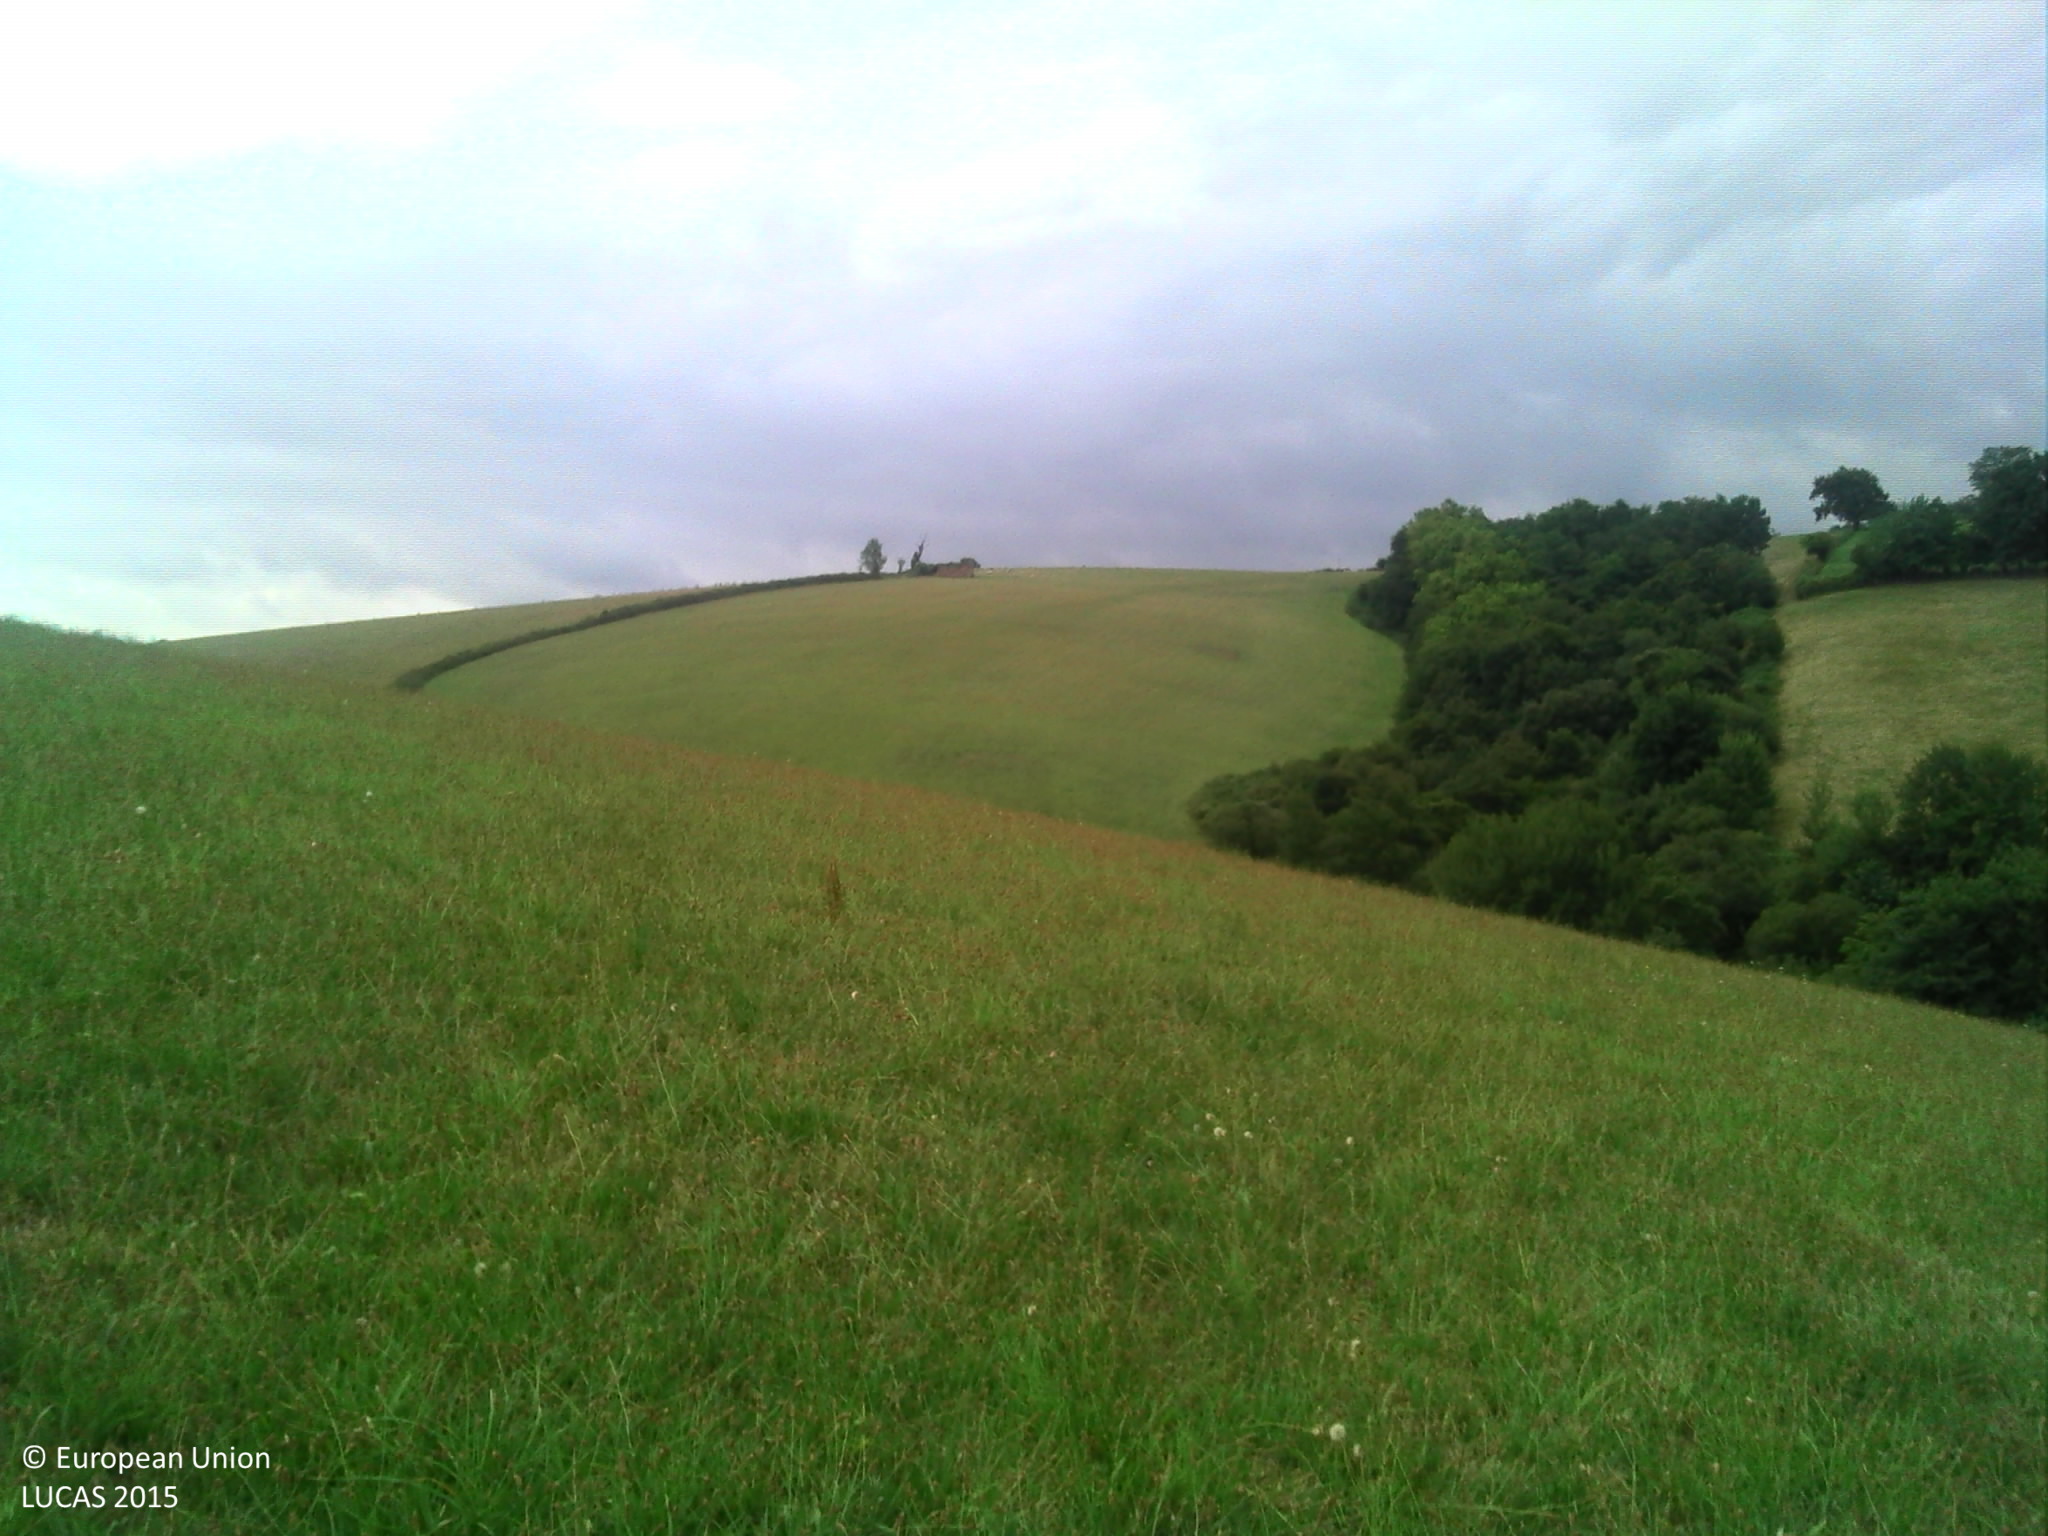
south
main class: Grassland
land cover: Grassland without tree/shrub cover
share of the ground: > 75 %
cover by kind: herbaceous plants 100 %
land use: Agriculture (excluding fallow land and kitchen gardens)
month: August
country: FR
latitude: 43.4156
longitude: -1.1919
